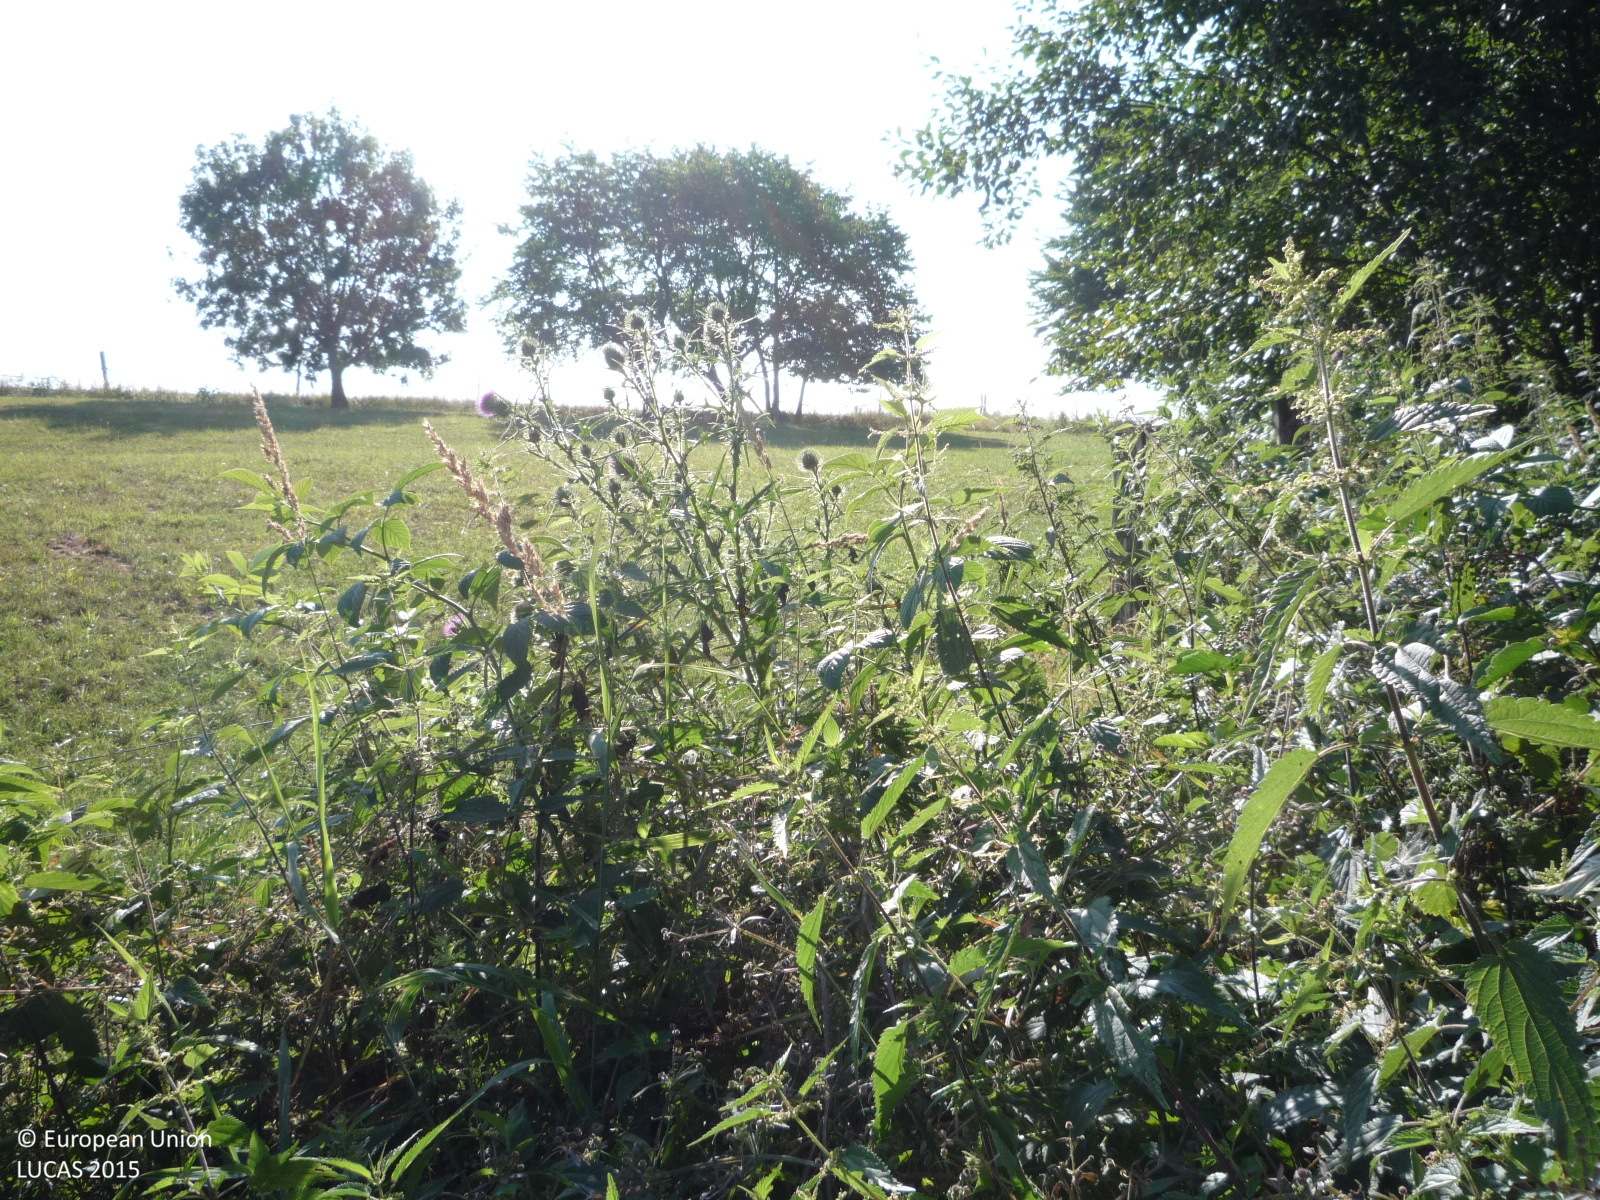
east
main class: Grassland
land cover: Grassland without tree/shrub cover
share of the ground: > 75 %
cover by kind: herbaceous plants 100 %
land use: Agriculture (excluding fallow land and kitchen gardens)
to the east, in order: Grassland without tree/shrub cover; Broadleaved woodland; Fences; Rape and turnip rape; Grassland with sparse tree/shrub cover; Tracks; Apple fruit
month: July
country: CZ
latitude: 50.4261
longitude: 15.1975
